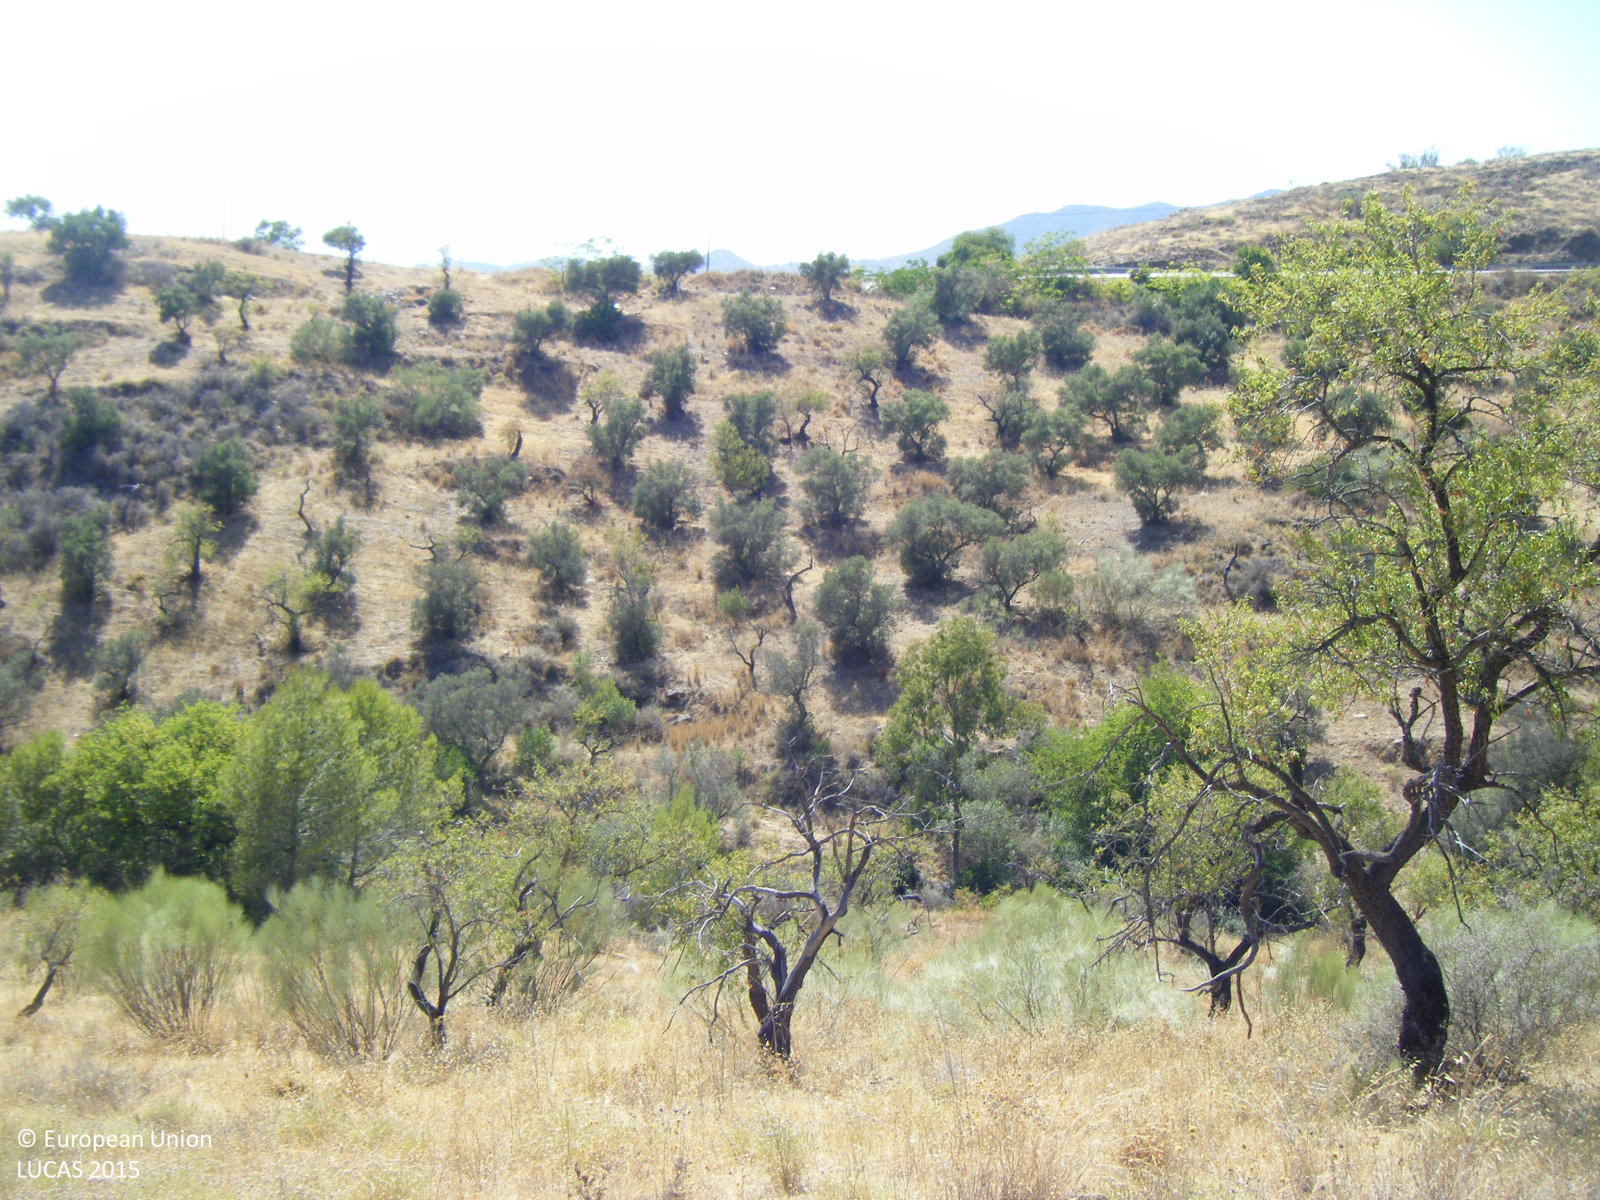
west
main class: Cropland
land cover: Nuts trees
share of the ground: 10 - 25 %
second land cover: Spontaneously vegetated surfaces
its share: > 75 %
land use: Abandoned areas
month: July
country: ES
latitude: 36.7547
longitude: -4.4062
